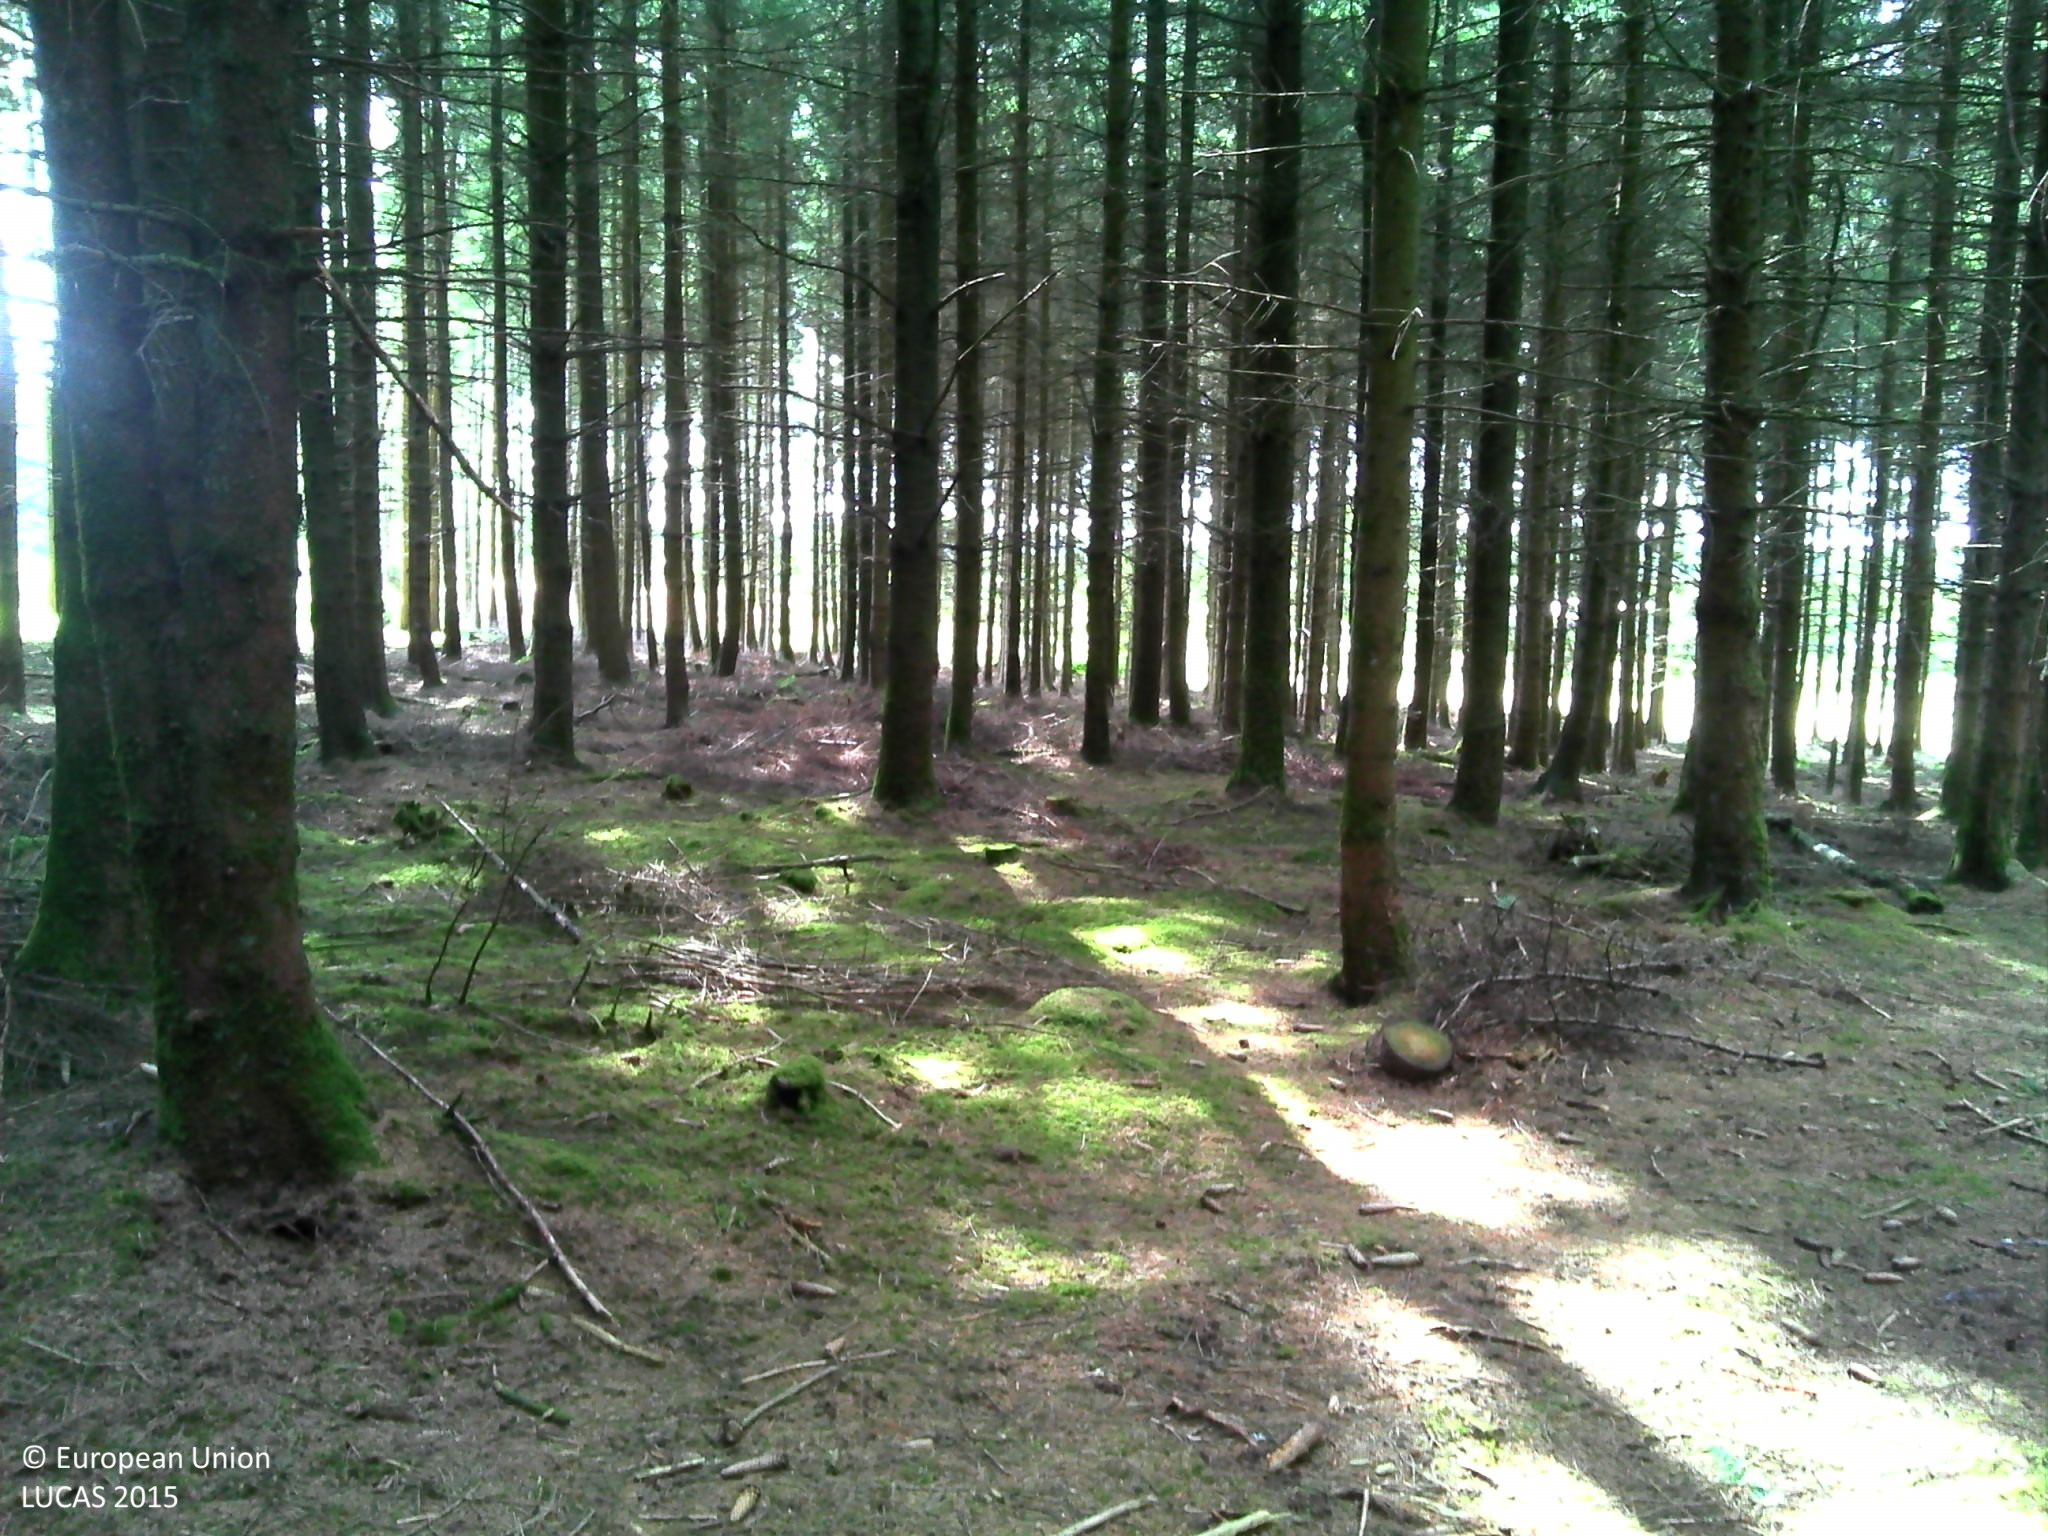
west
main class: Woodland
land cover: Spruce dominated coniferous woodland
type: hemiboreal forest and nemoral coniferous forest and mixed broadleaved-coniferous forest
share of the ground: > 75 %
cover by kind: coniferous forest trees 95 %, lichens and mosses 5 %
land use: Forestry
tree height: > 5 m
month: July
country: BE
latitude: 49.8447
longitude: 5.5346
